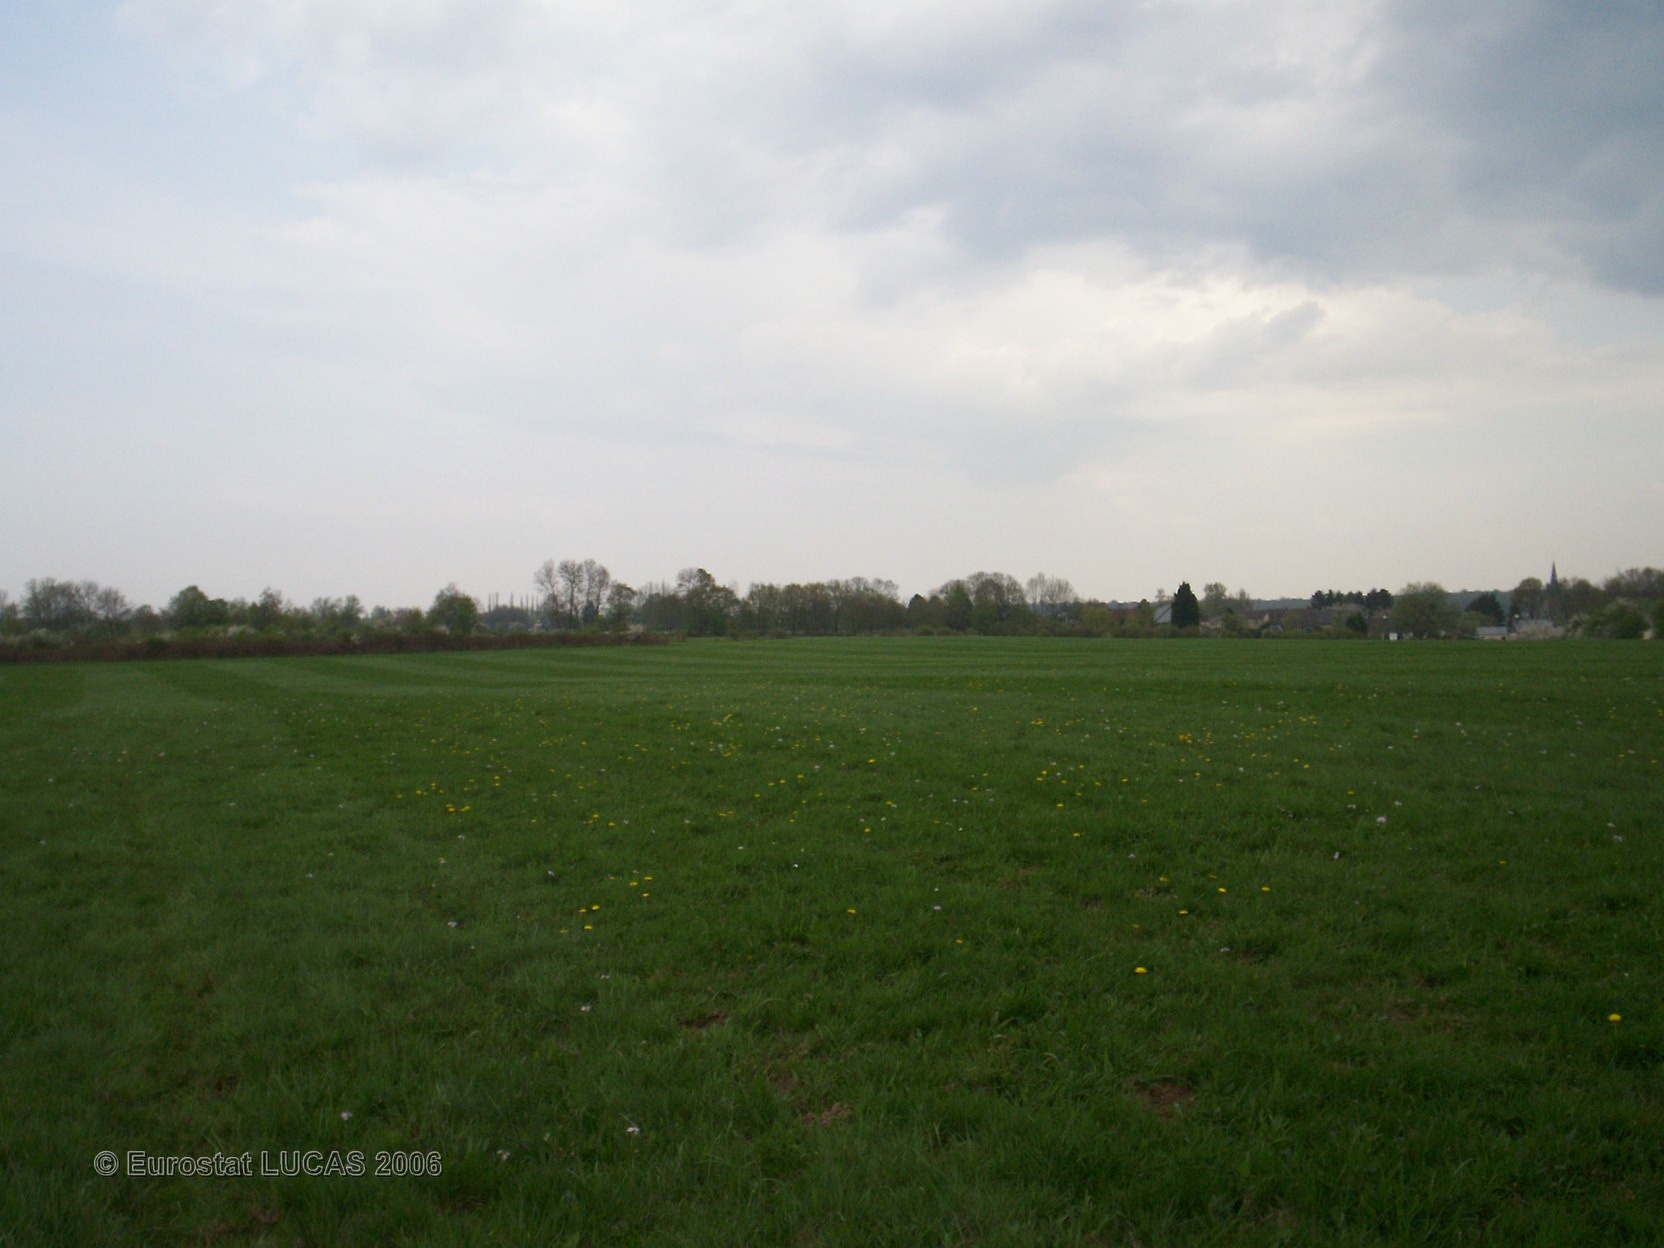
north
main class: Grassland
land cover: Grassland without tree/shrub cover
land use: Agriculture (excluding fallow land and kitchen gardens)
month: May
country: FR
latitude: 49.8961
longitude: 4.2738
